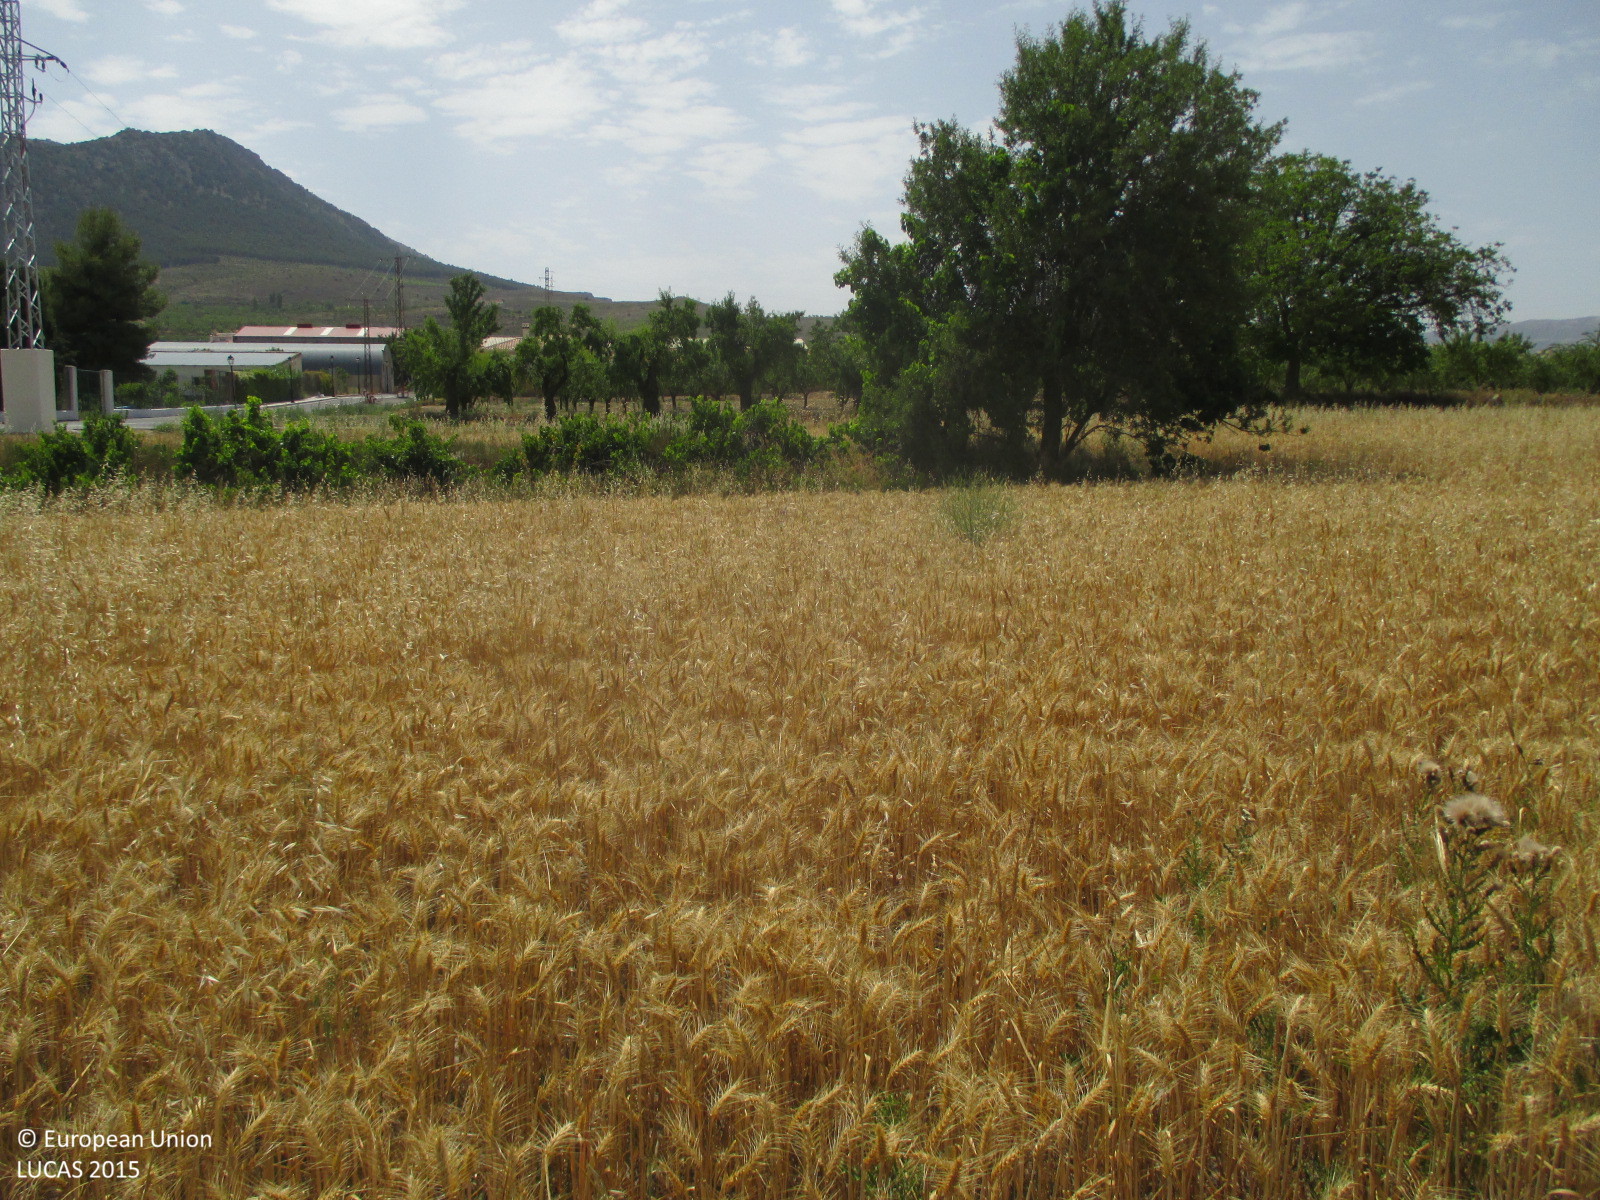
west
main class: Cropland
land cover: Common wheat
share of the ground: 50 - 75 %
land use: Agriculture (excluding fallow land and kitchen gardens)
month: July
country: ES
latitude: 37.9546
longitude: -2.4305
